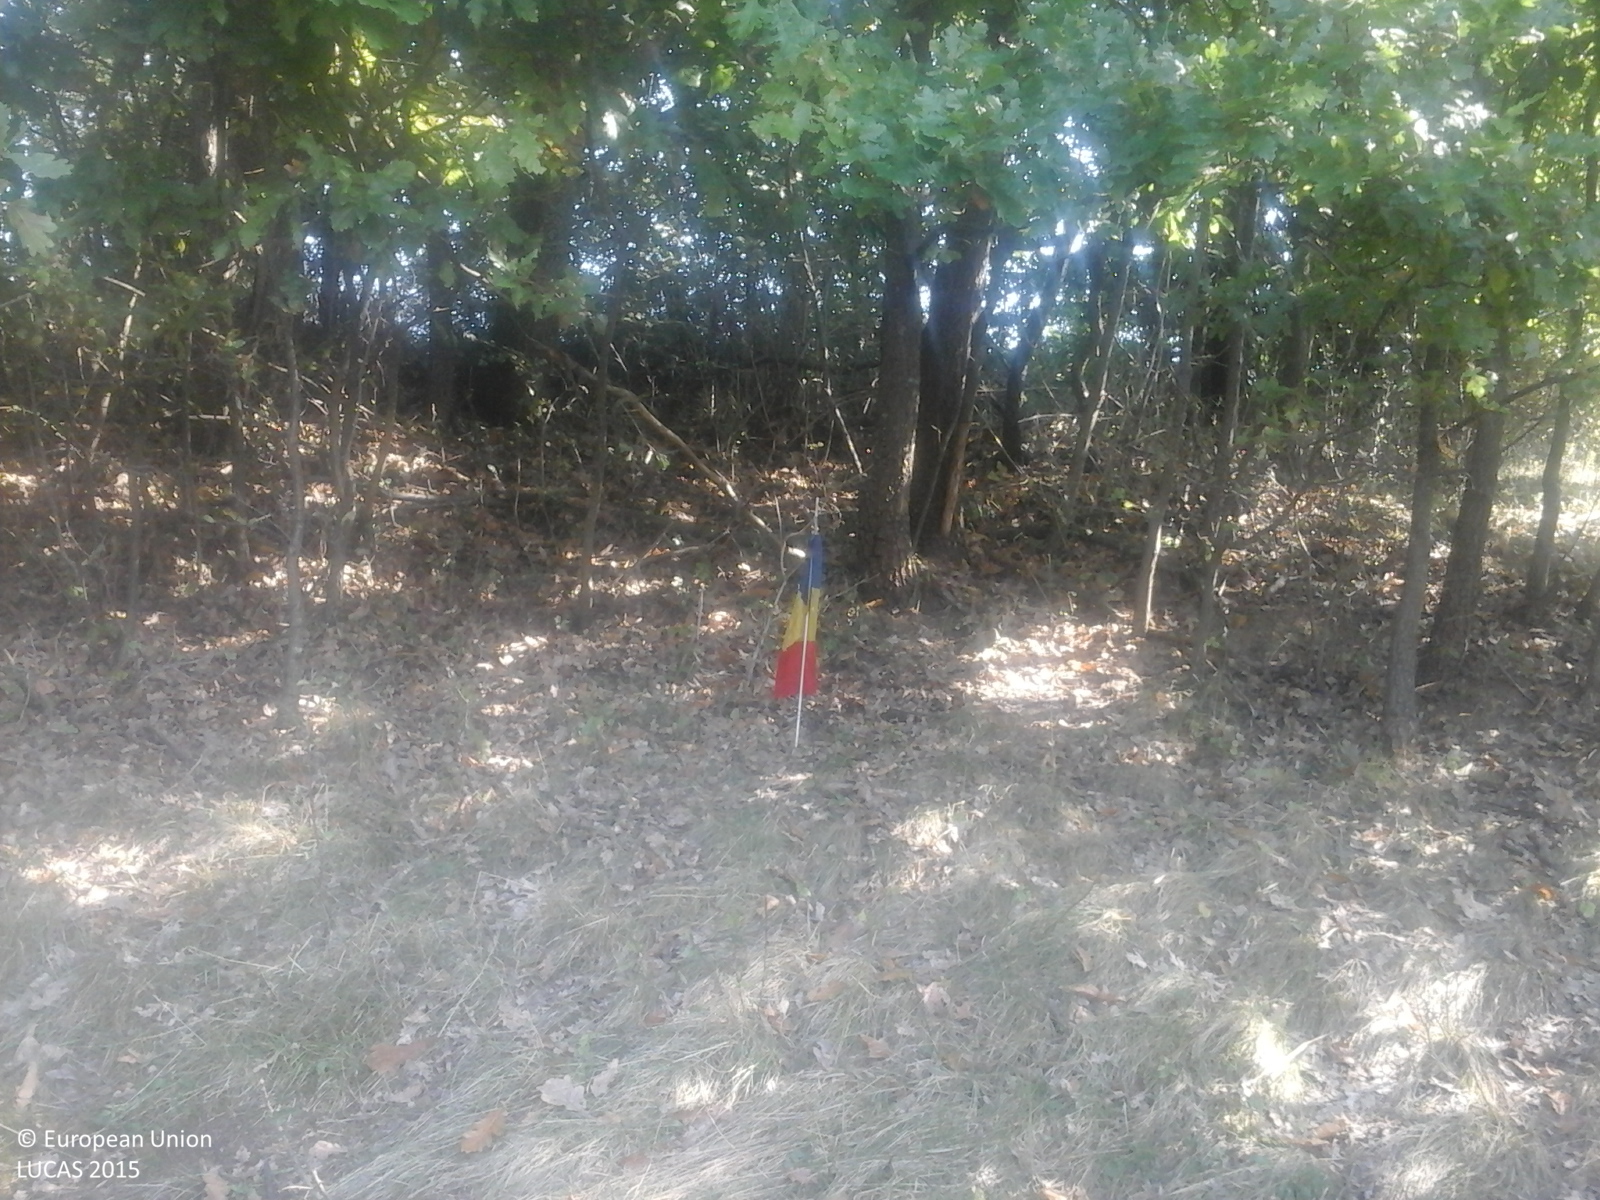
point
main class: Woodland
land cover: Broadleaved woodland
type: acidophilous oak and oak-birch forest
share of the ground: > 75 %
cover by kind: broadleaved forest trees 100 %
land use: Forestry
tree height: > 5 m
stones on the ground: 10 - 25 %
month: September
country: RO
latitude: 45.8869
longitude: 22.5089
